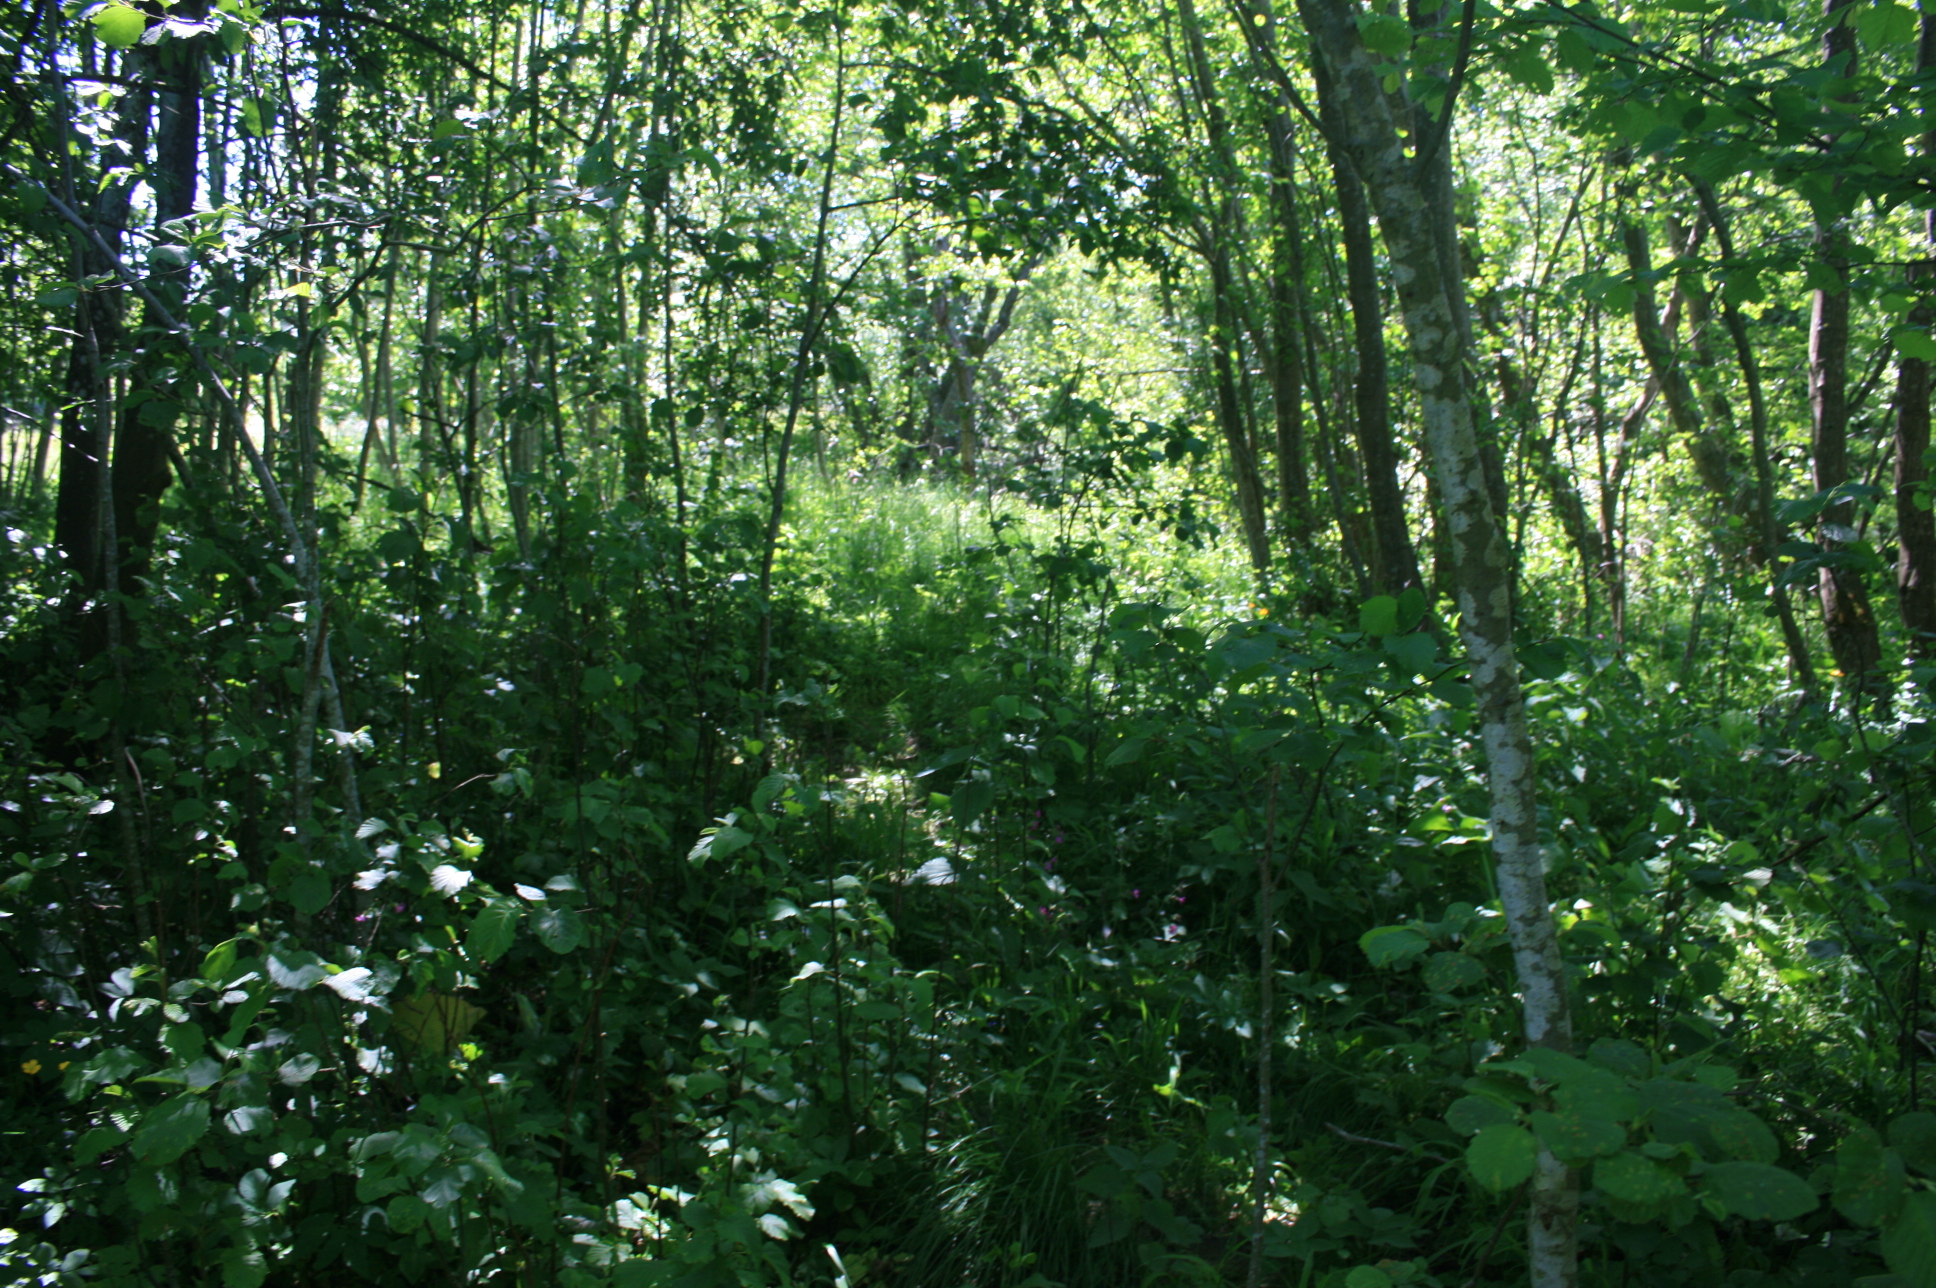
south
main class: Woodland
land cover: Broadleaved woodland
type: floodplain forest
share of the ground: > 75 %
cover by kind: broadleaved forest trees 90 %, herbaceous plants 5 %, unconsolidated bare surface 5 %
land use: Semi-natural and natural areas not in use
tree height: > 5 m
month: June
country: LT
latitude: 55.5532
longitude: 22.1503
